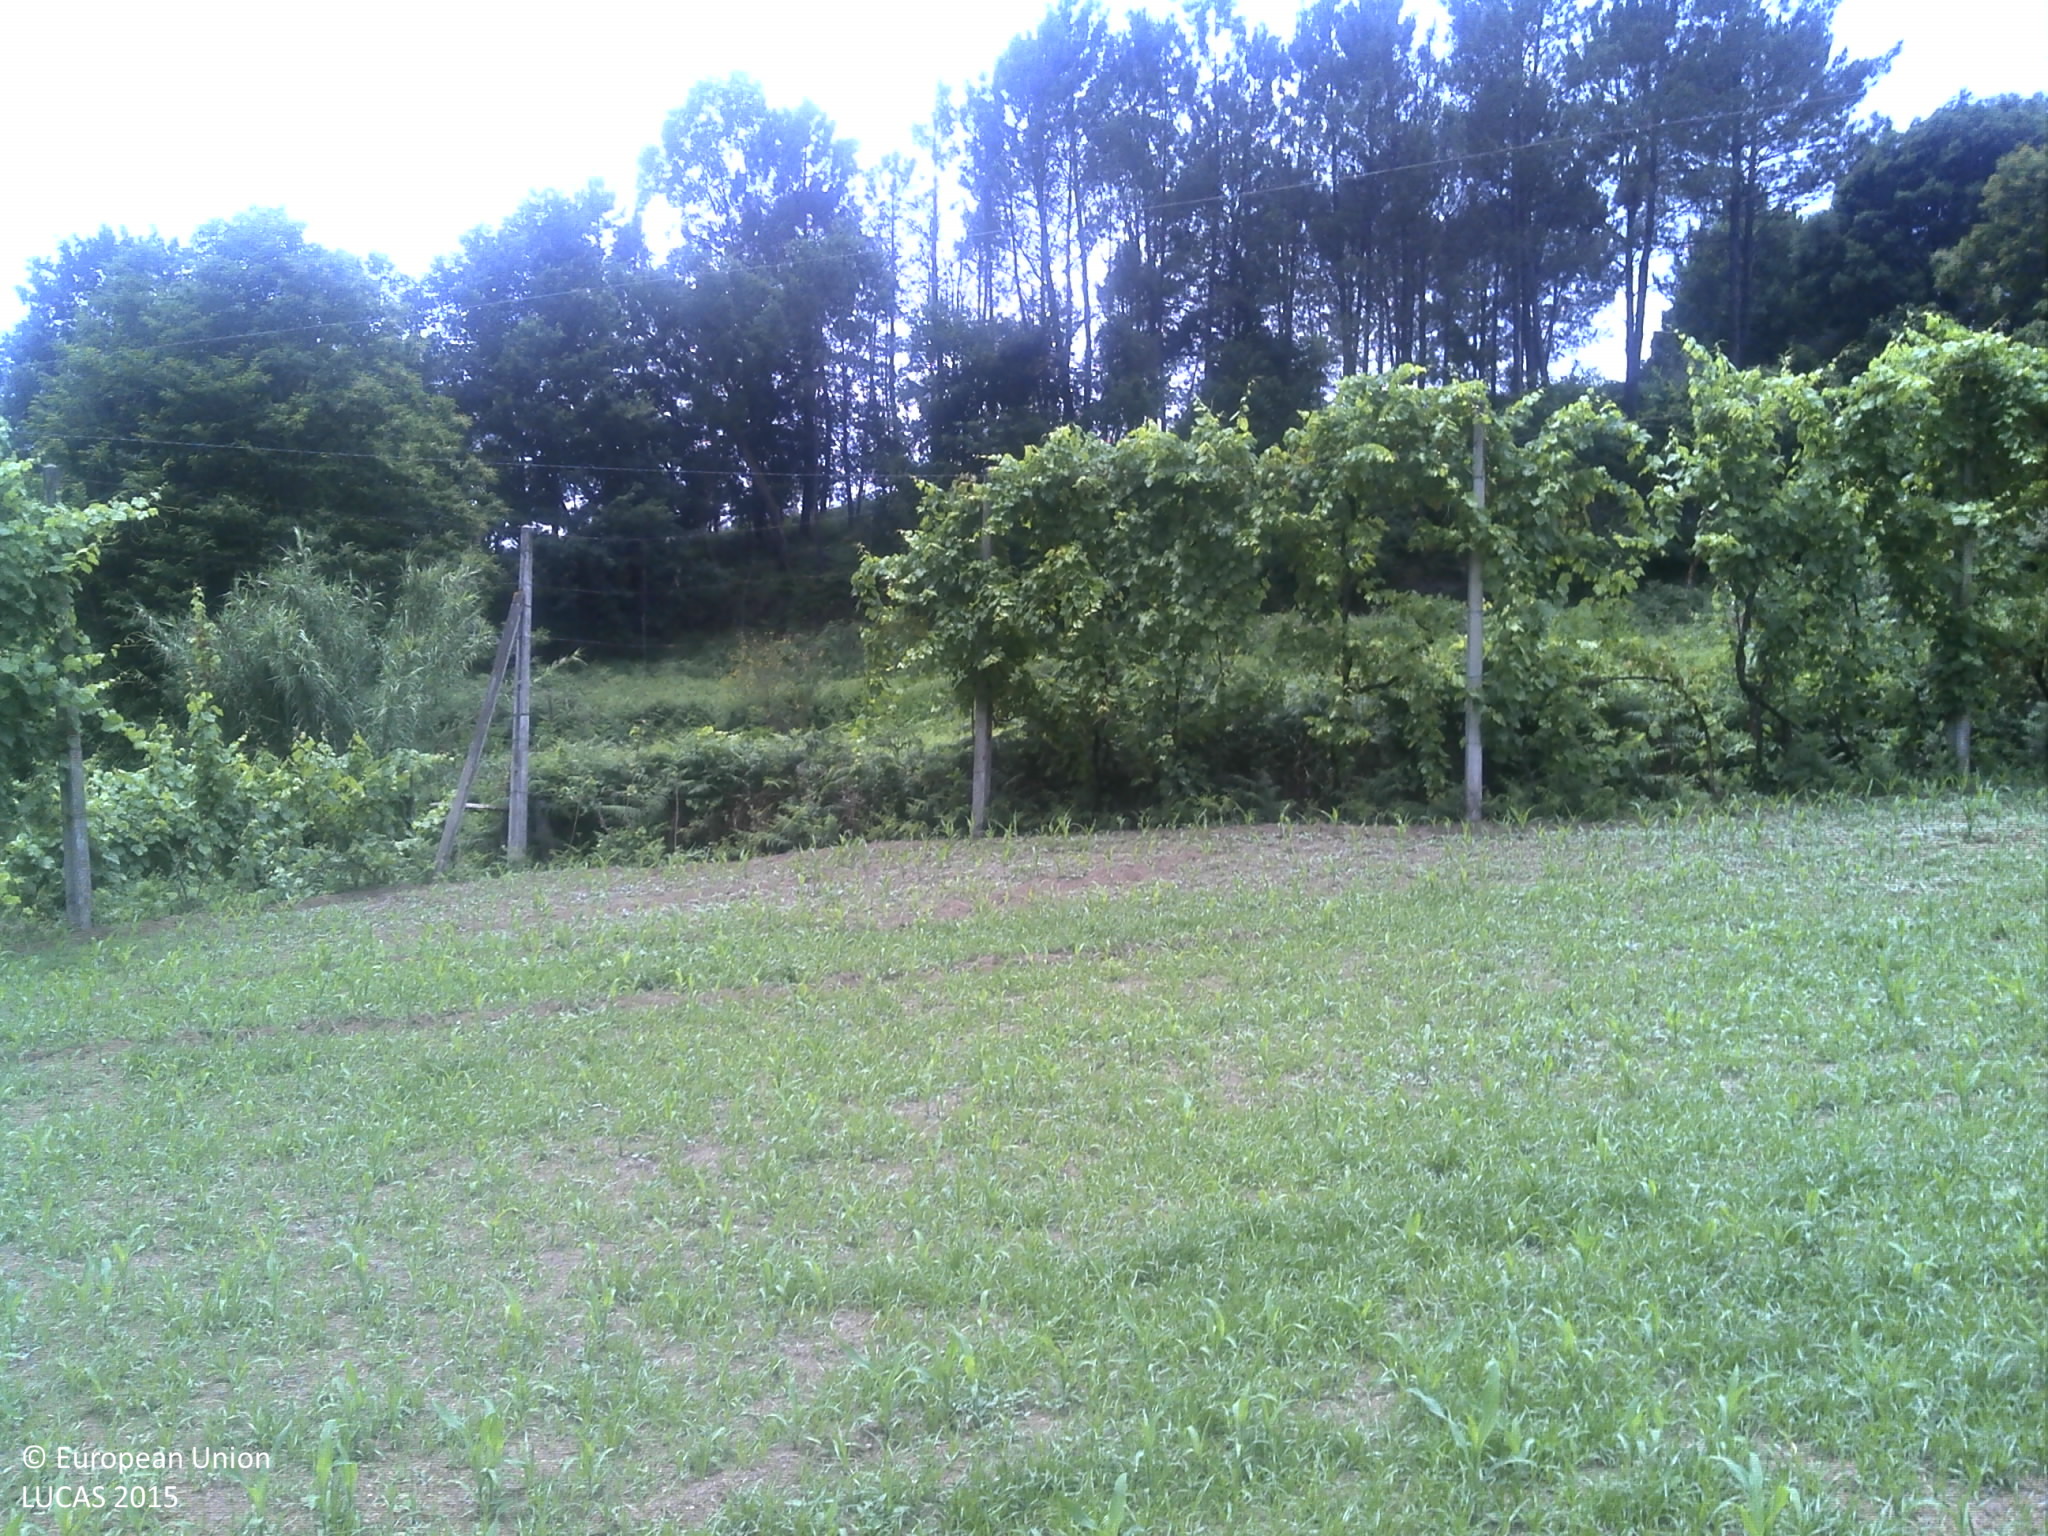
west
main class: Cropland
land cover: Maize
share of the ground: 10 - 25 %
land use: Agriculture (excluding fallow land and kitchen gardens)
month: June
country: PT
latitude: 41.6323
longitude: -8.3139
